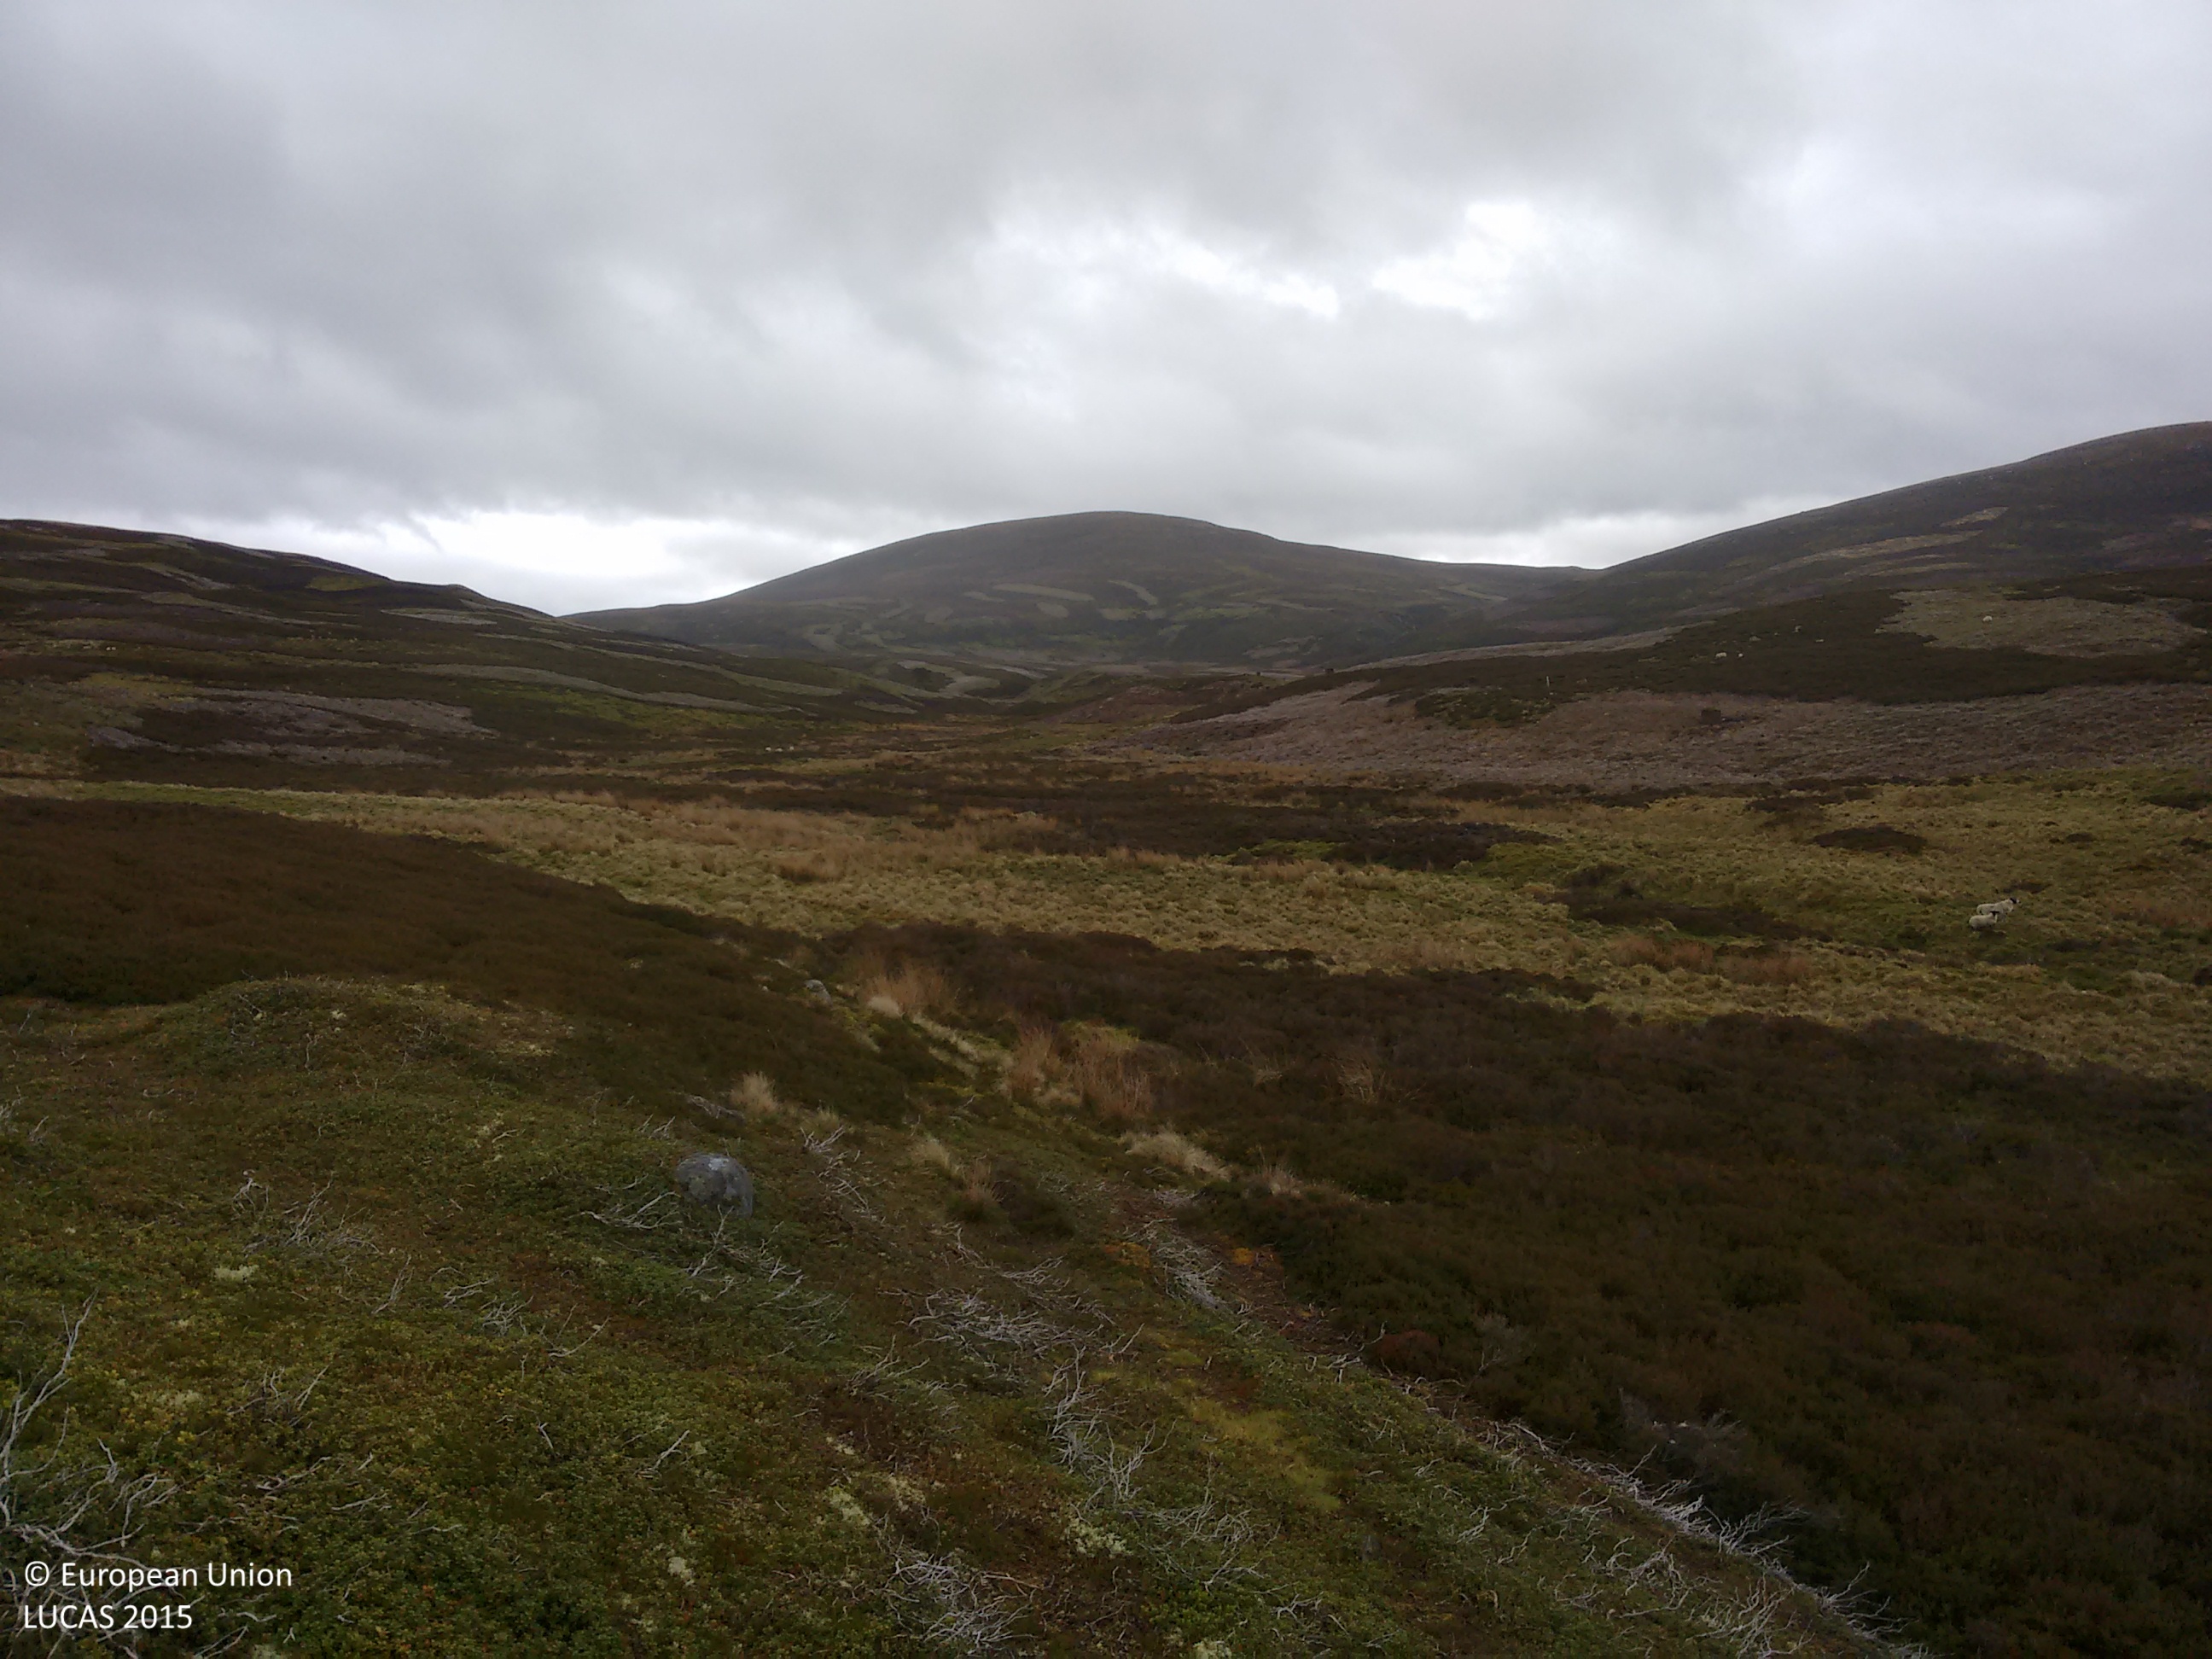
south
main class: Shrubland
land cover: Shrubland without tree cover
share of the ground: > 75 %
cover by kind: shrubs 85 %, herbaceous plants 5 %, lichens and mosses 5 %
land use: Agriculture (excluding fallow land and kitchen gardens)
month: June
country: GB
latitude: 57.1474
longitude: -3.1728
